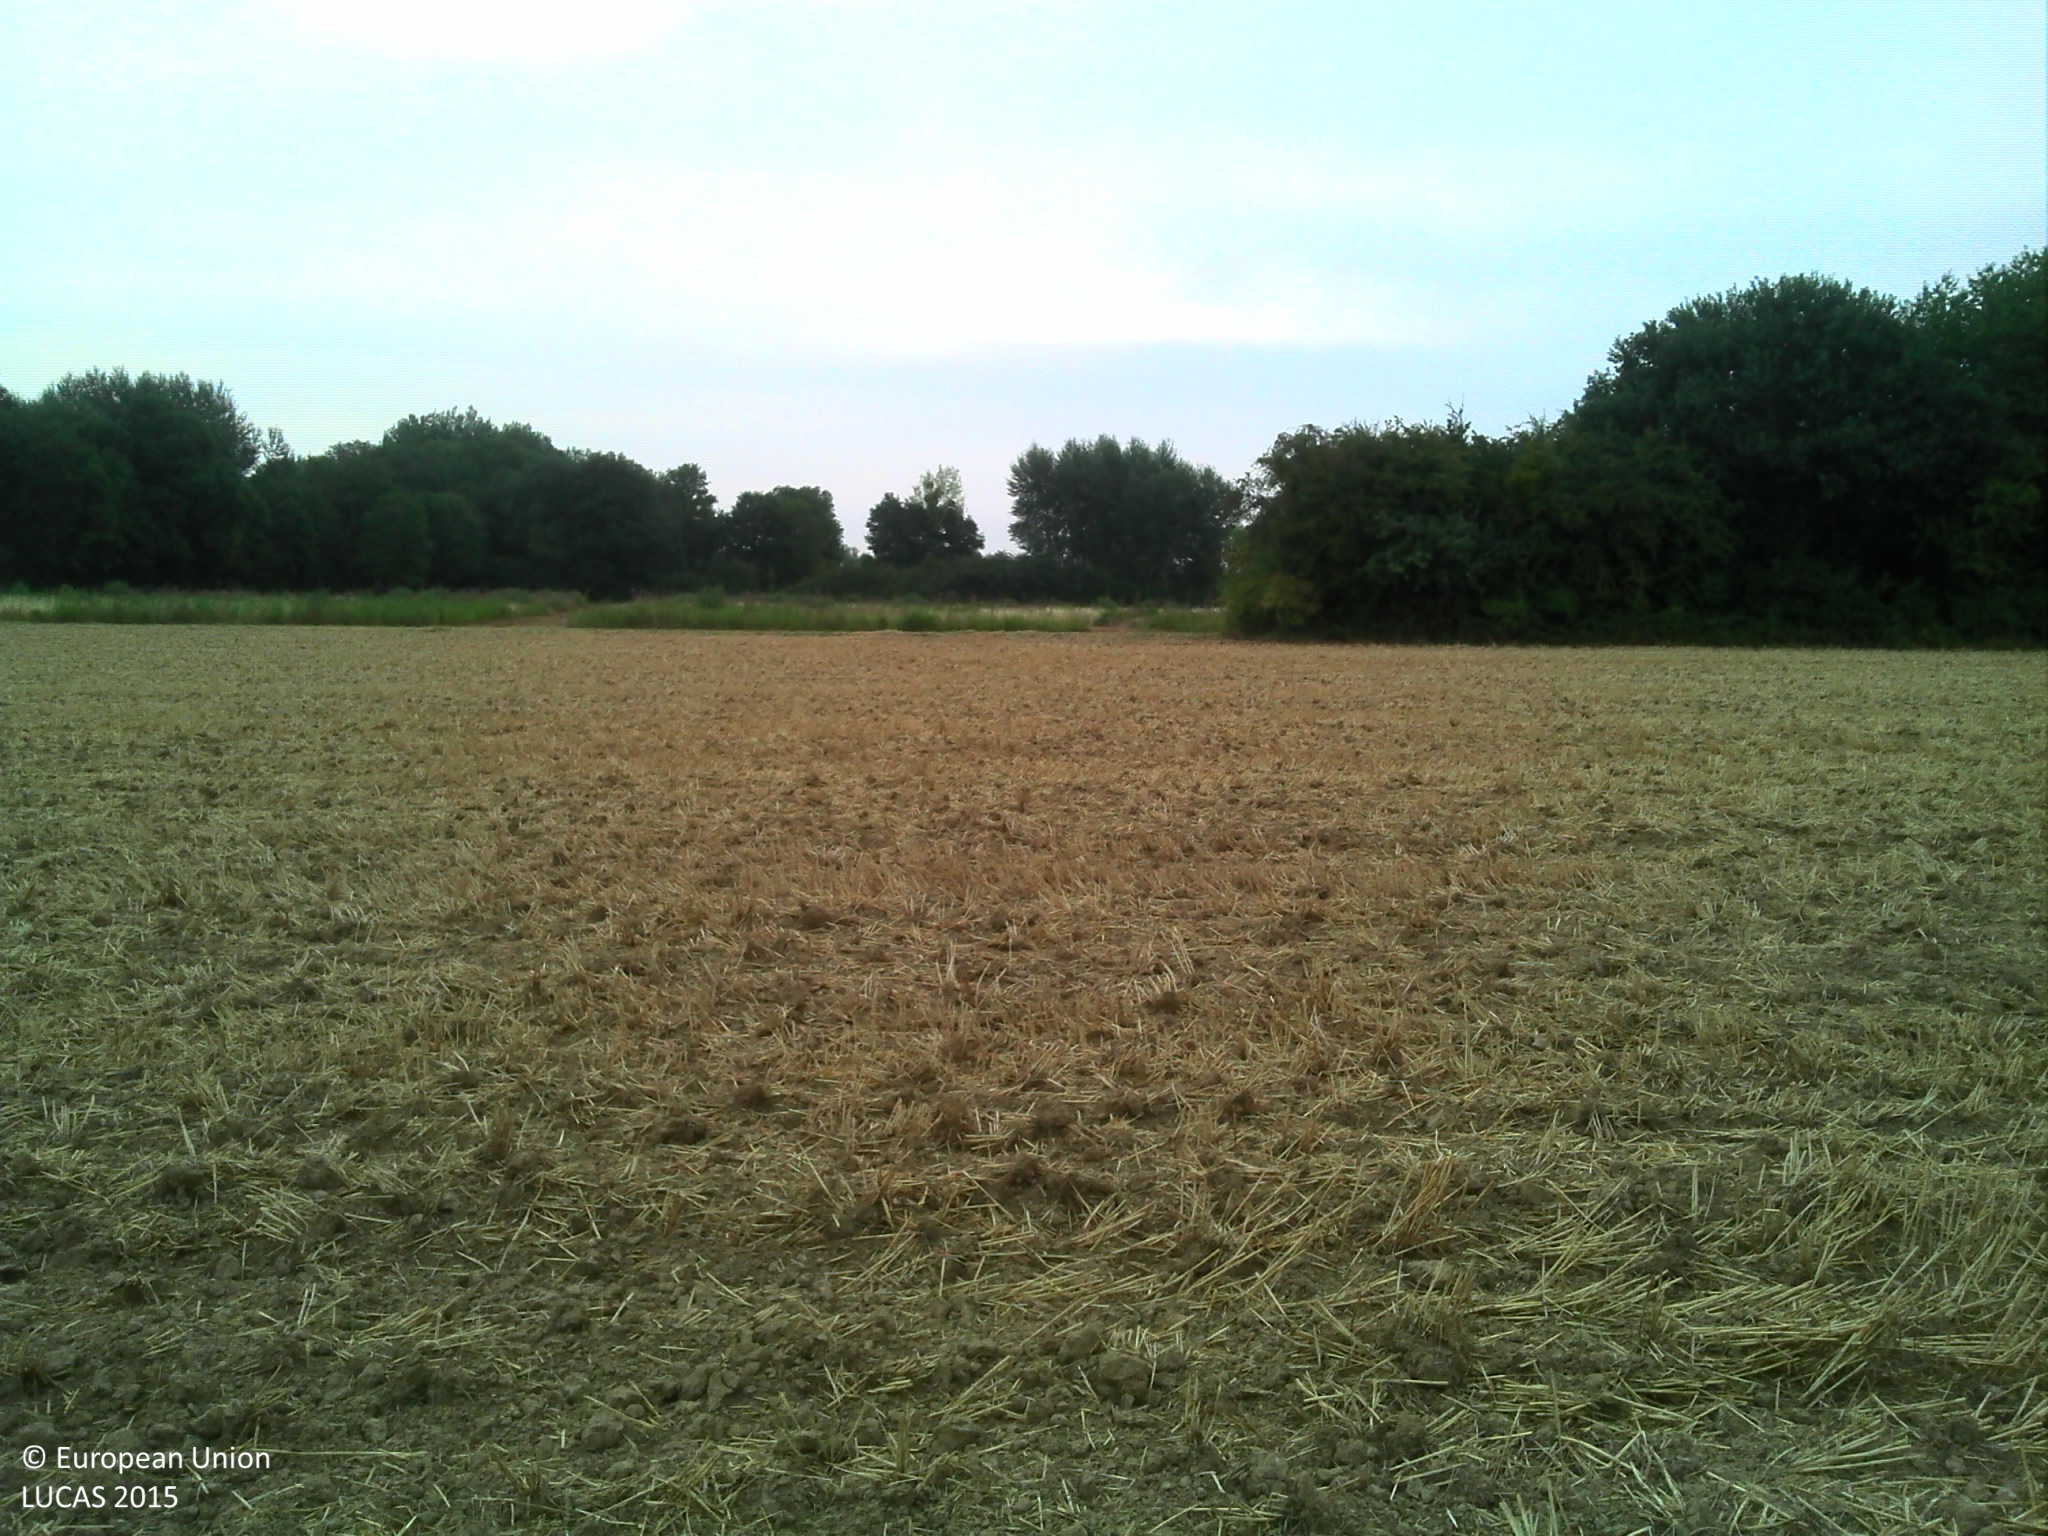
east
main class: Cropland
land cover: Maize
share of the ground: > 75 %
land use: Agriculture (excluding fallow land and kitchen gardens)
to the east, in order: Maize; Common wheat; Grassland without tree/shrub cover; Shrubland without tree cover; Grassland without tree/shrub cover
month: August
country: FR
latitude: 48.7926
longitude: 2.9536
